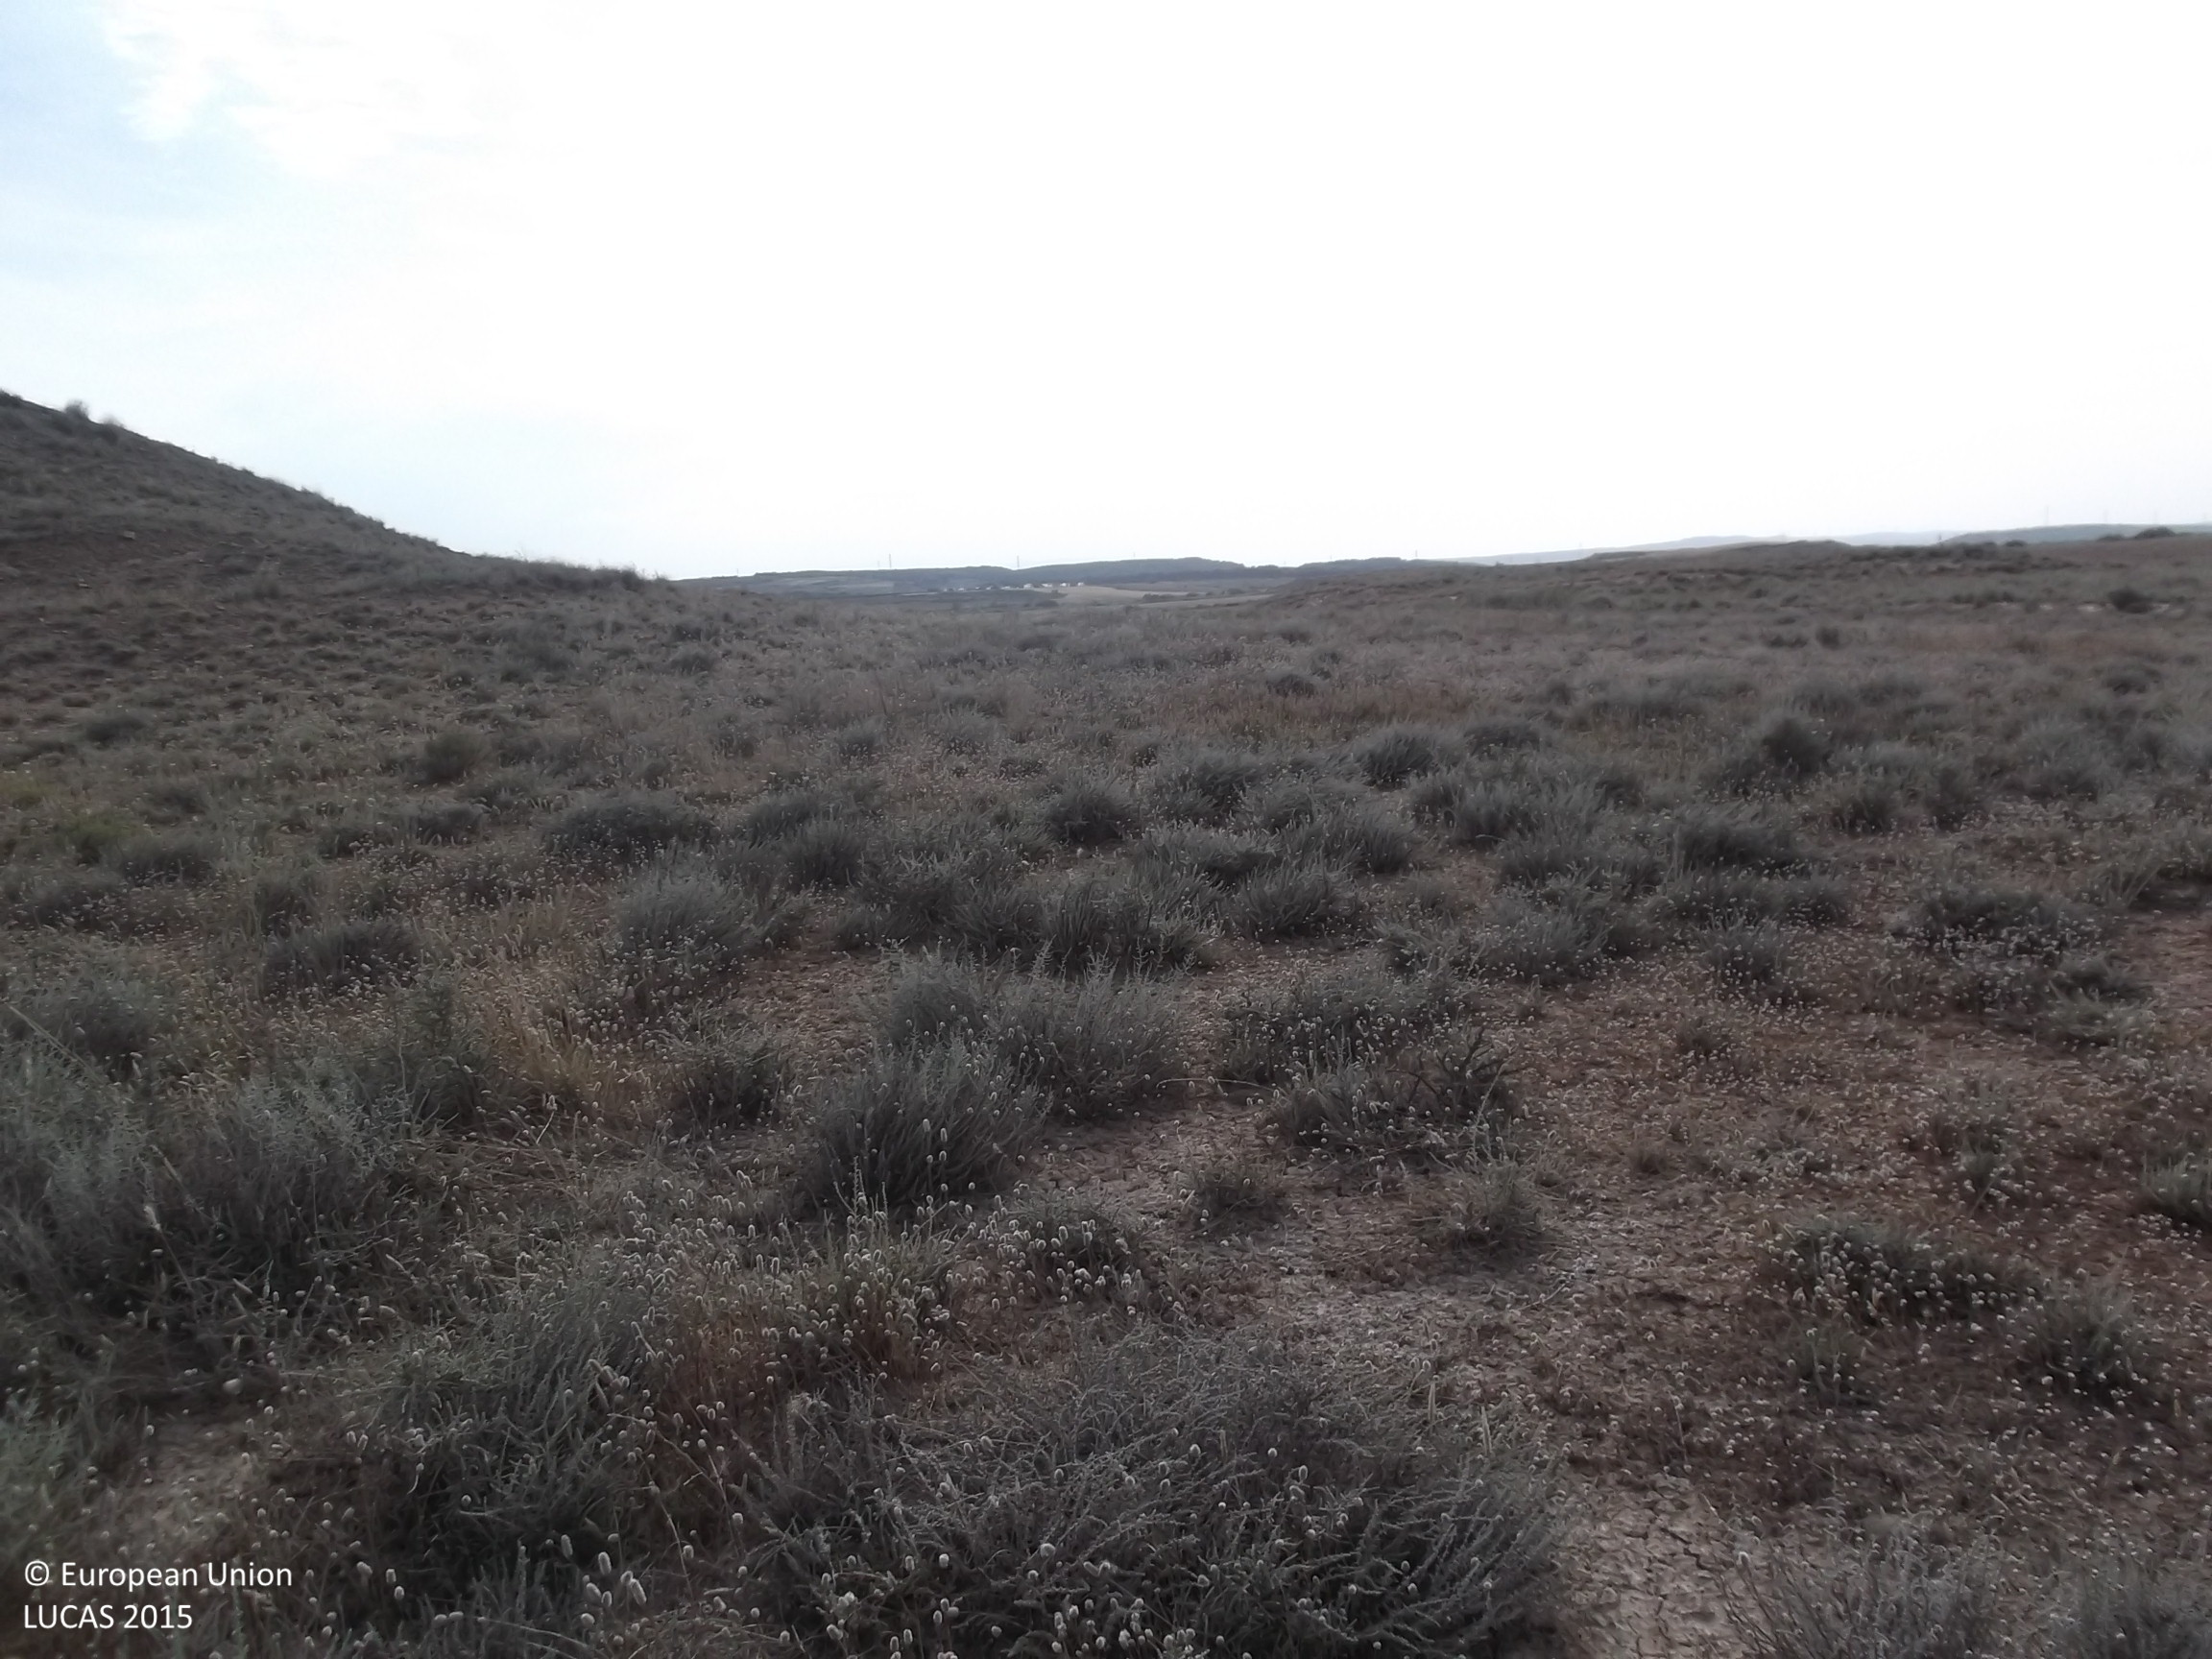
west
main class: Shrubland
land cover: Shrubland without tree cover
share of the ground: 50 - 75 %
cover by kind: shrubs 70 %, herbaceous plants 15 %, unconsolidated bare surface 10 %
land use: Semi-natural and natural areas not in use
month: July
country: ES
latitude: 42.2546
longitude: -1.6339
